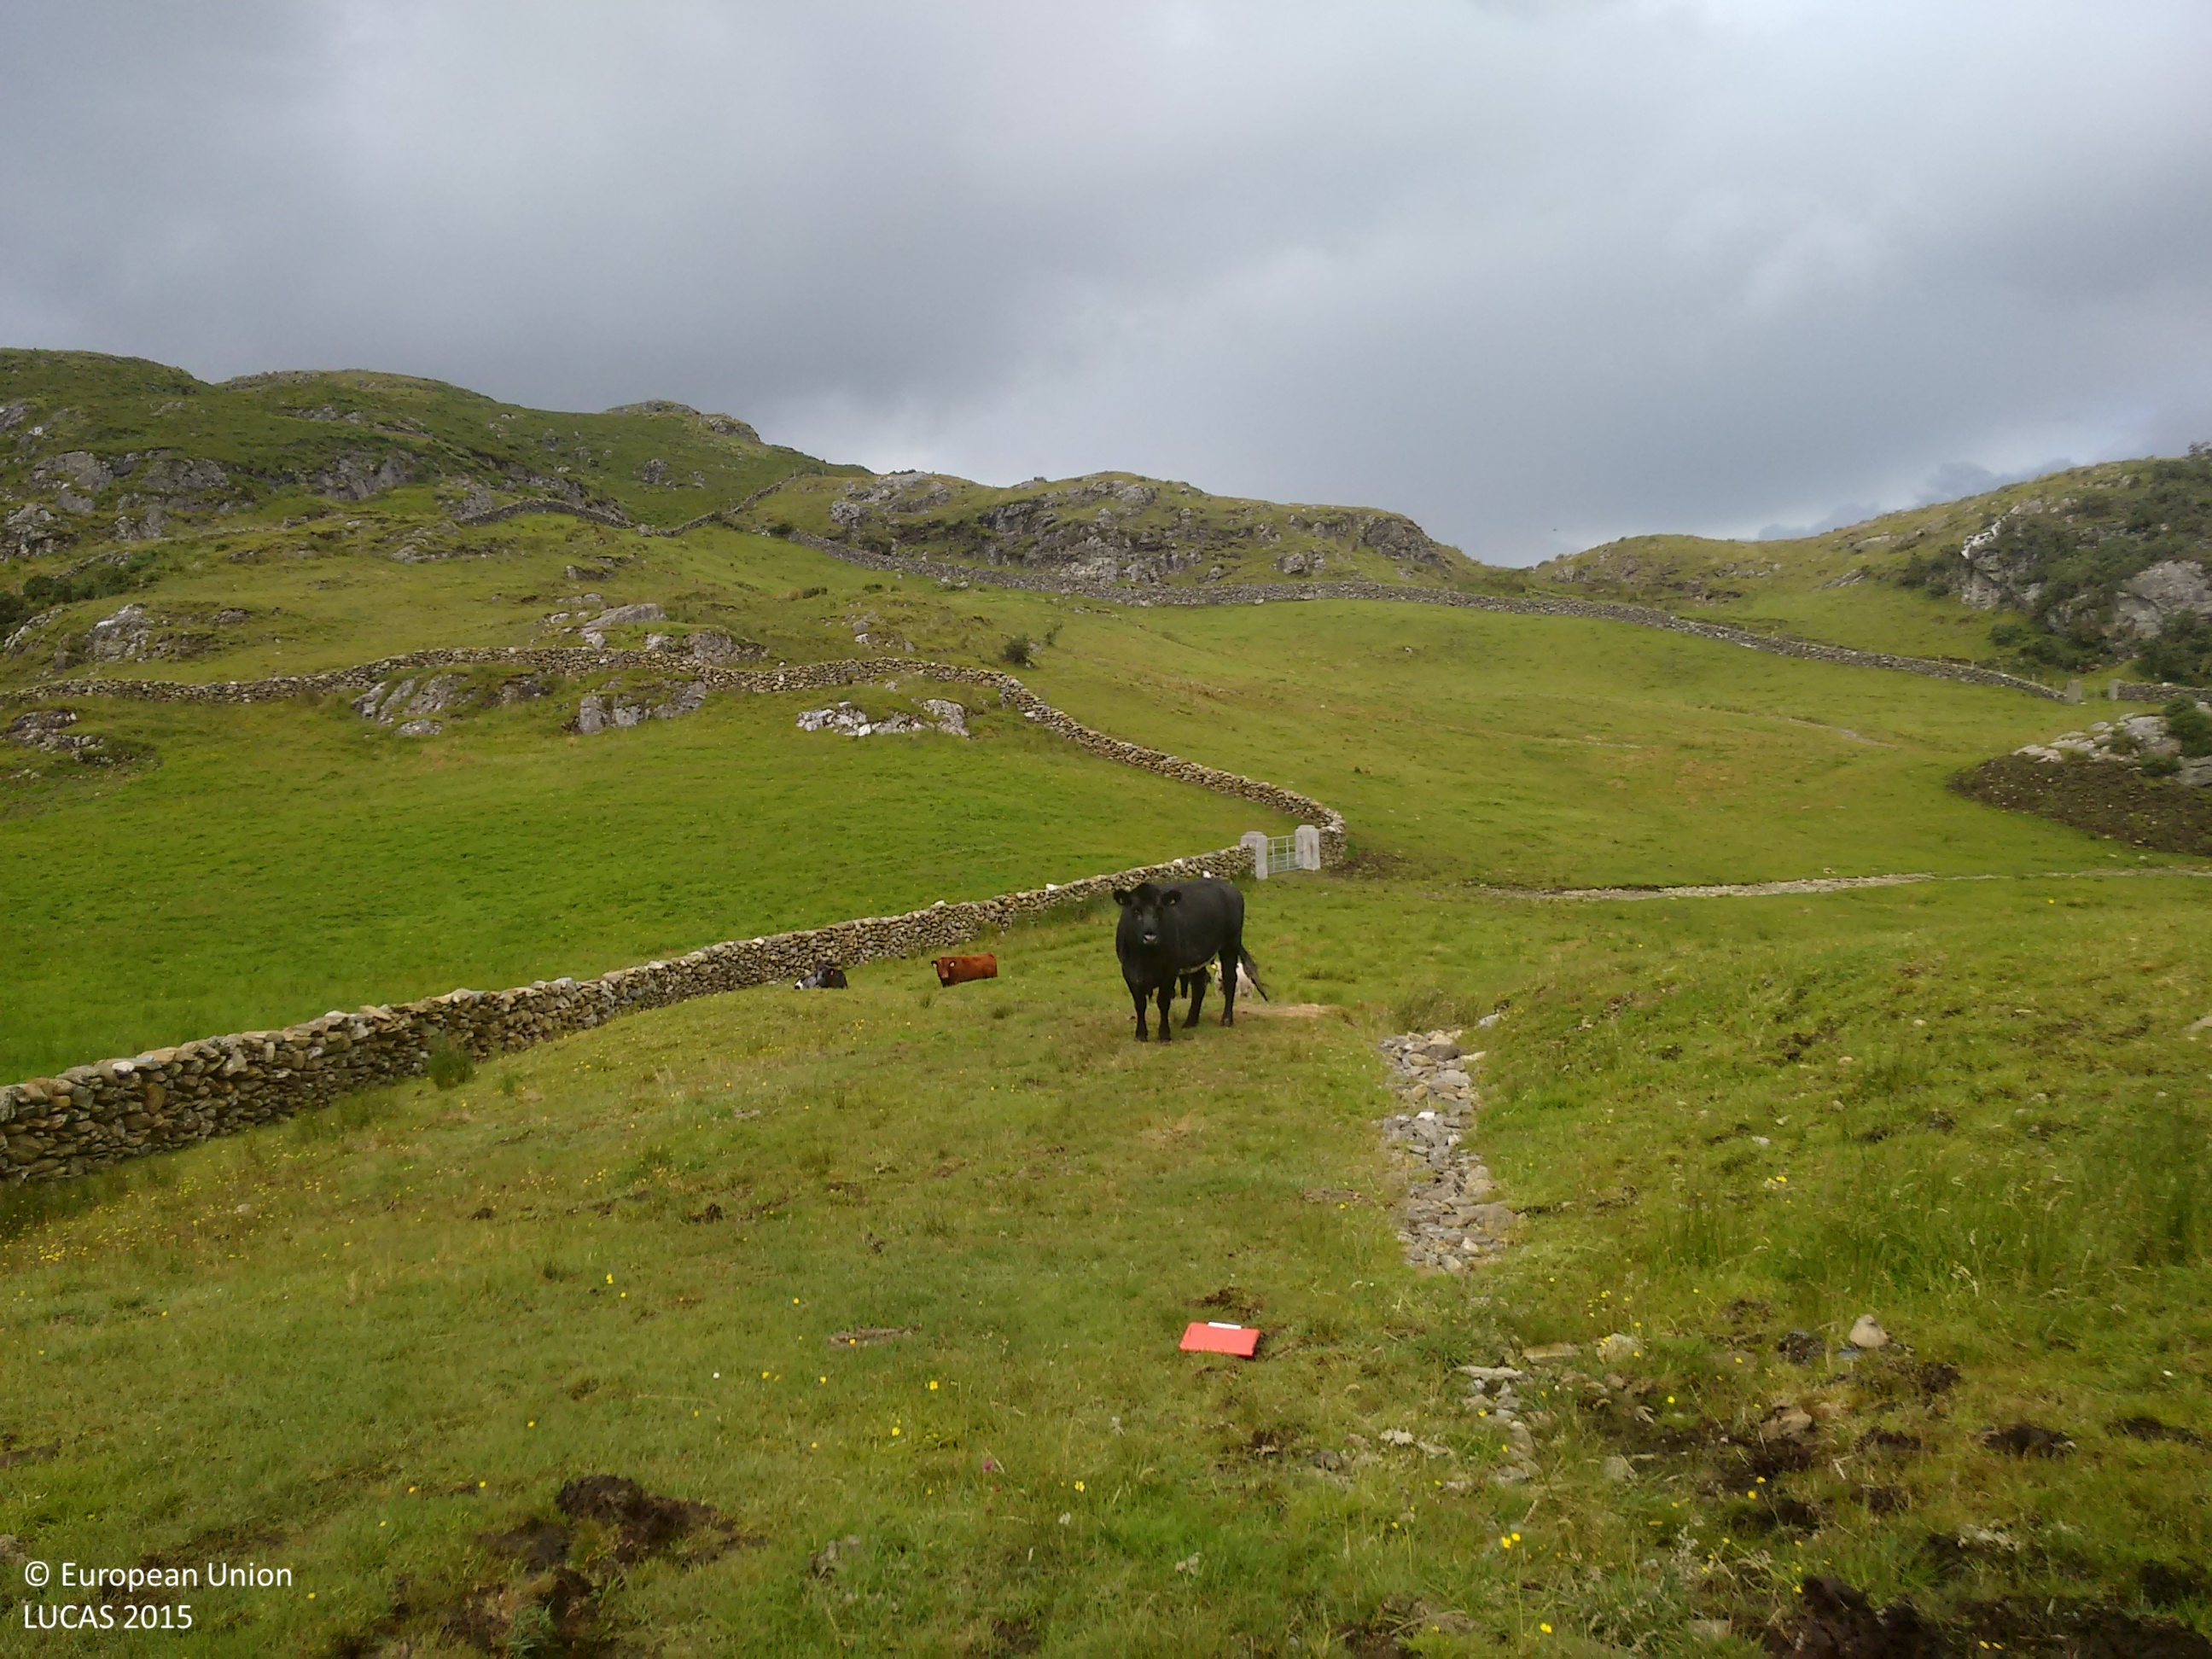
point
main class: Grassland
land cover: Grassland without tree/shrub cover
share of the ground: > 75 %
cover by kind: herbaceous plants 100 %
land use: Agriculture (excluding fallow land and kitchen gardens)
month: July
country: IE
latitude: 53.5013
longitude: -9.4838
